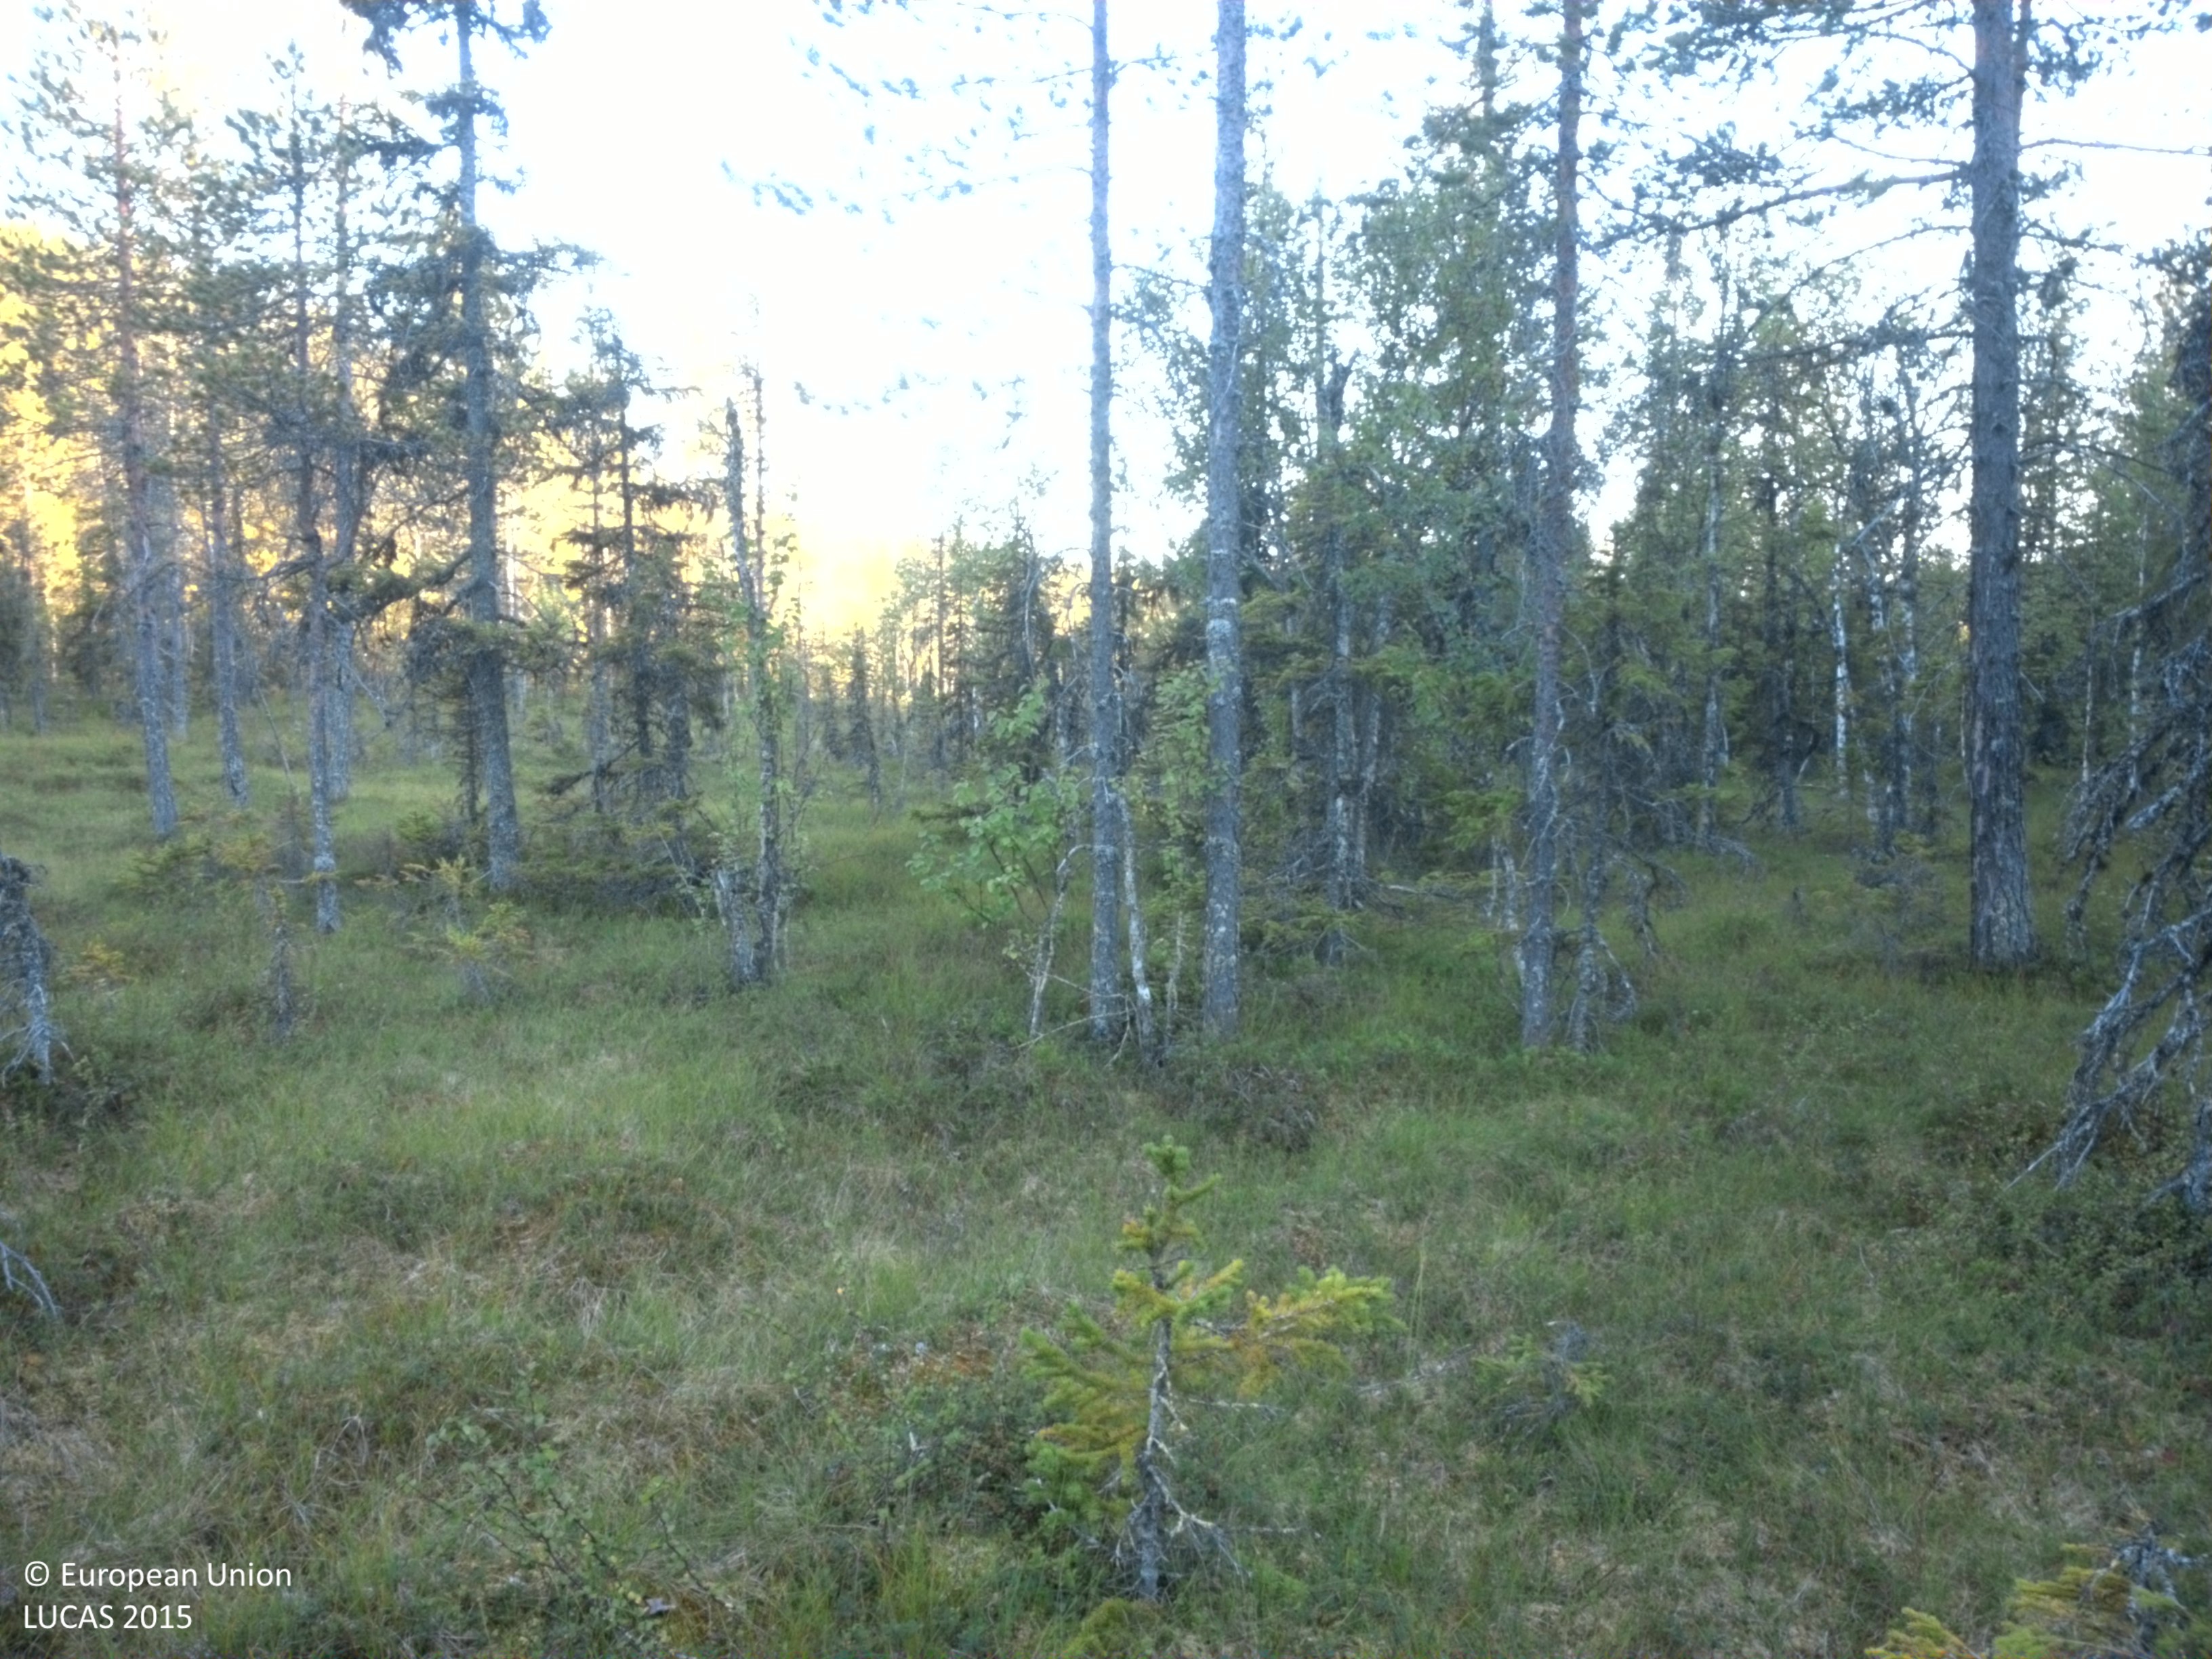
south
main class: Woodland
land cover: Pine dominated coniferous woodland
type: boreal forest
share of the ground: 25 - 50 %
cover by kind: coniferous forest trees 35 %, lichens and mosses 30 %, herbaceous plants 20 %, shrubs 15 %
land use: Forestry
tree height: > 5 m
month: August
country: SE
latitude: 64.4514
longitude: 18.6767
